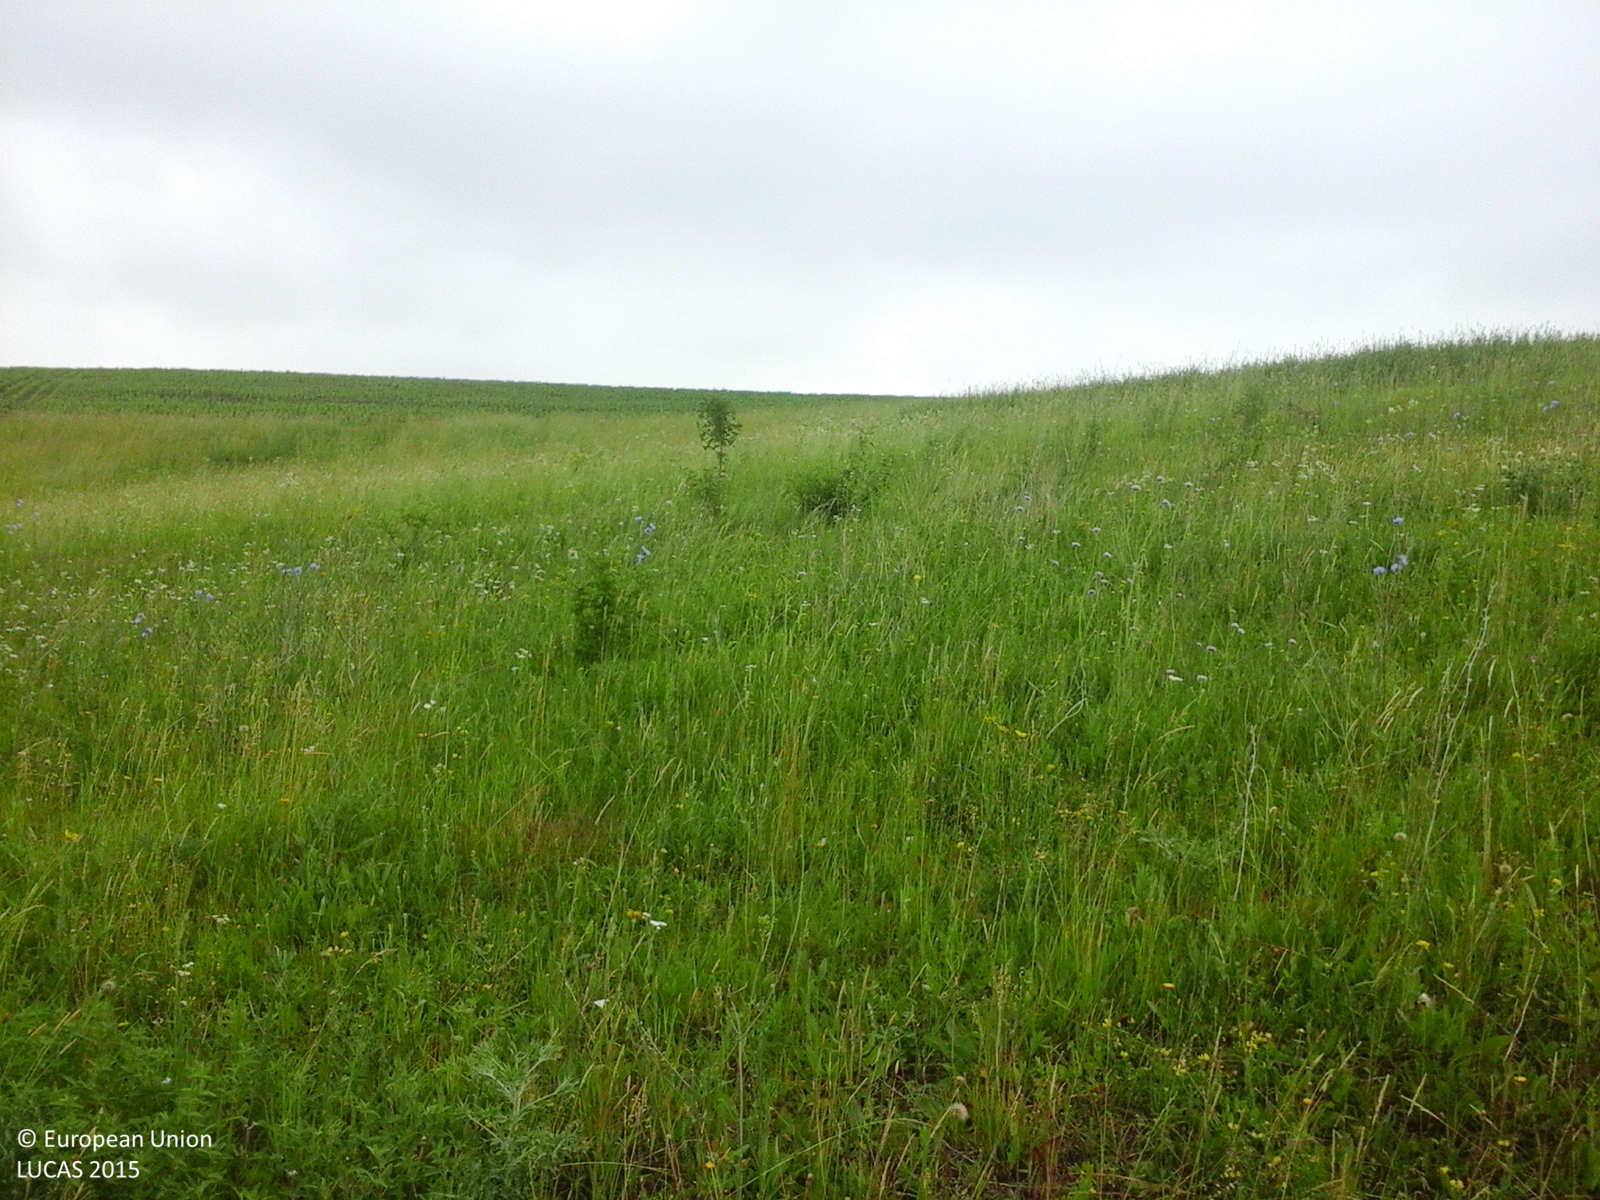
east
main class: Grassland
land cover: Grassland without tree/shrub cover
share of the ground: > 75 %
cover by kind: herbaceous plants 100 %
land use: Agriculture (excluding fallow land and kitchen gardens)
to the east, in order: Grassland without tree/shrub cover; Maize
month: June
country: RO
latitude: 47.3931
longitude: 26.3669
